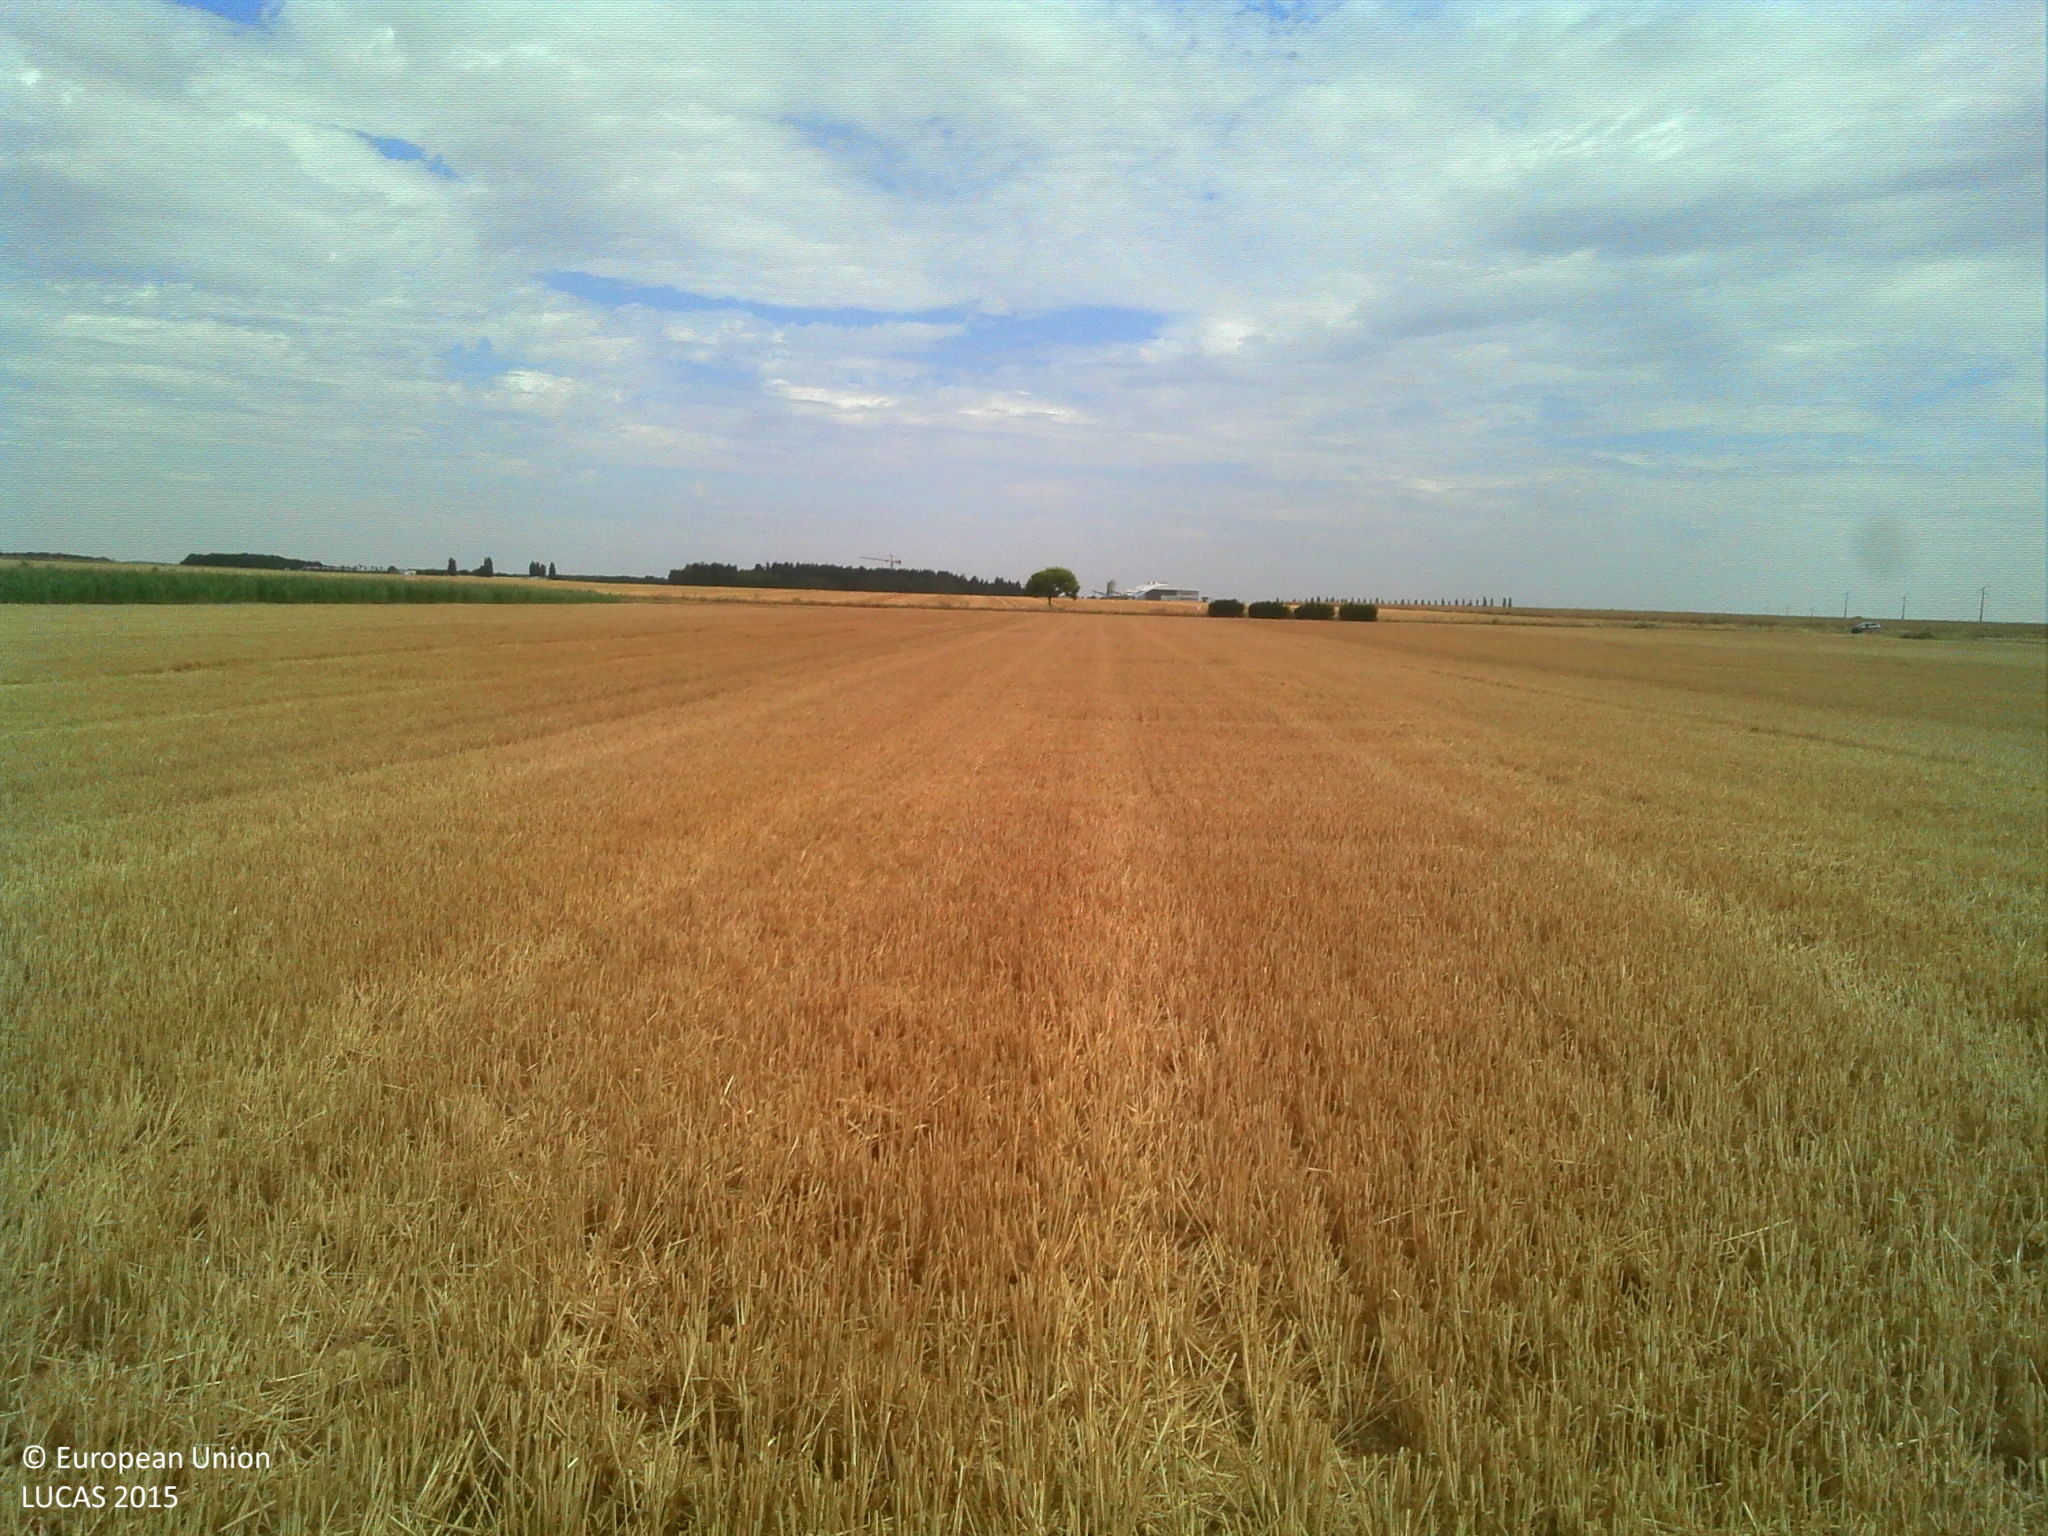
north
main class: Cropland
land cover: Common wheat
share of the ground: > 75 %
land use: Agriculture (excluding fallow land and kitchen gardens)
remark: Harvested field
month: July
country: FR
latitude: 48.4498
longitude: 1.4244
